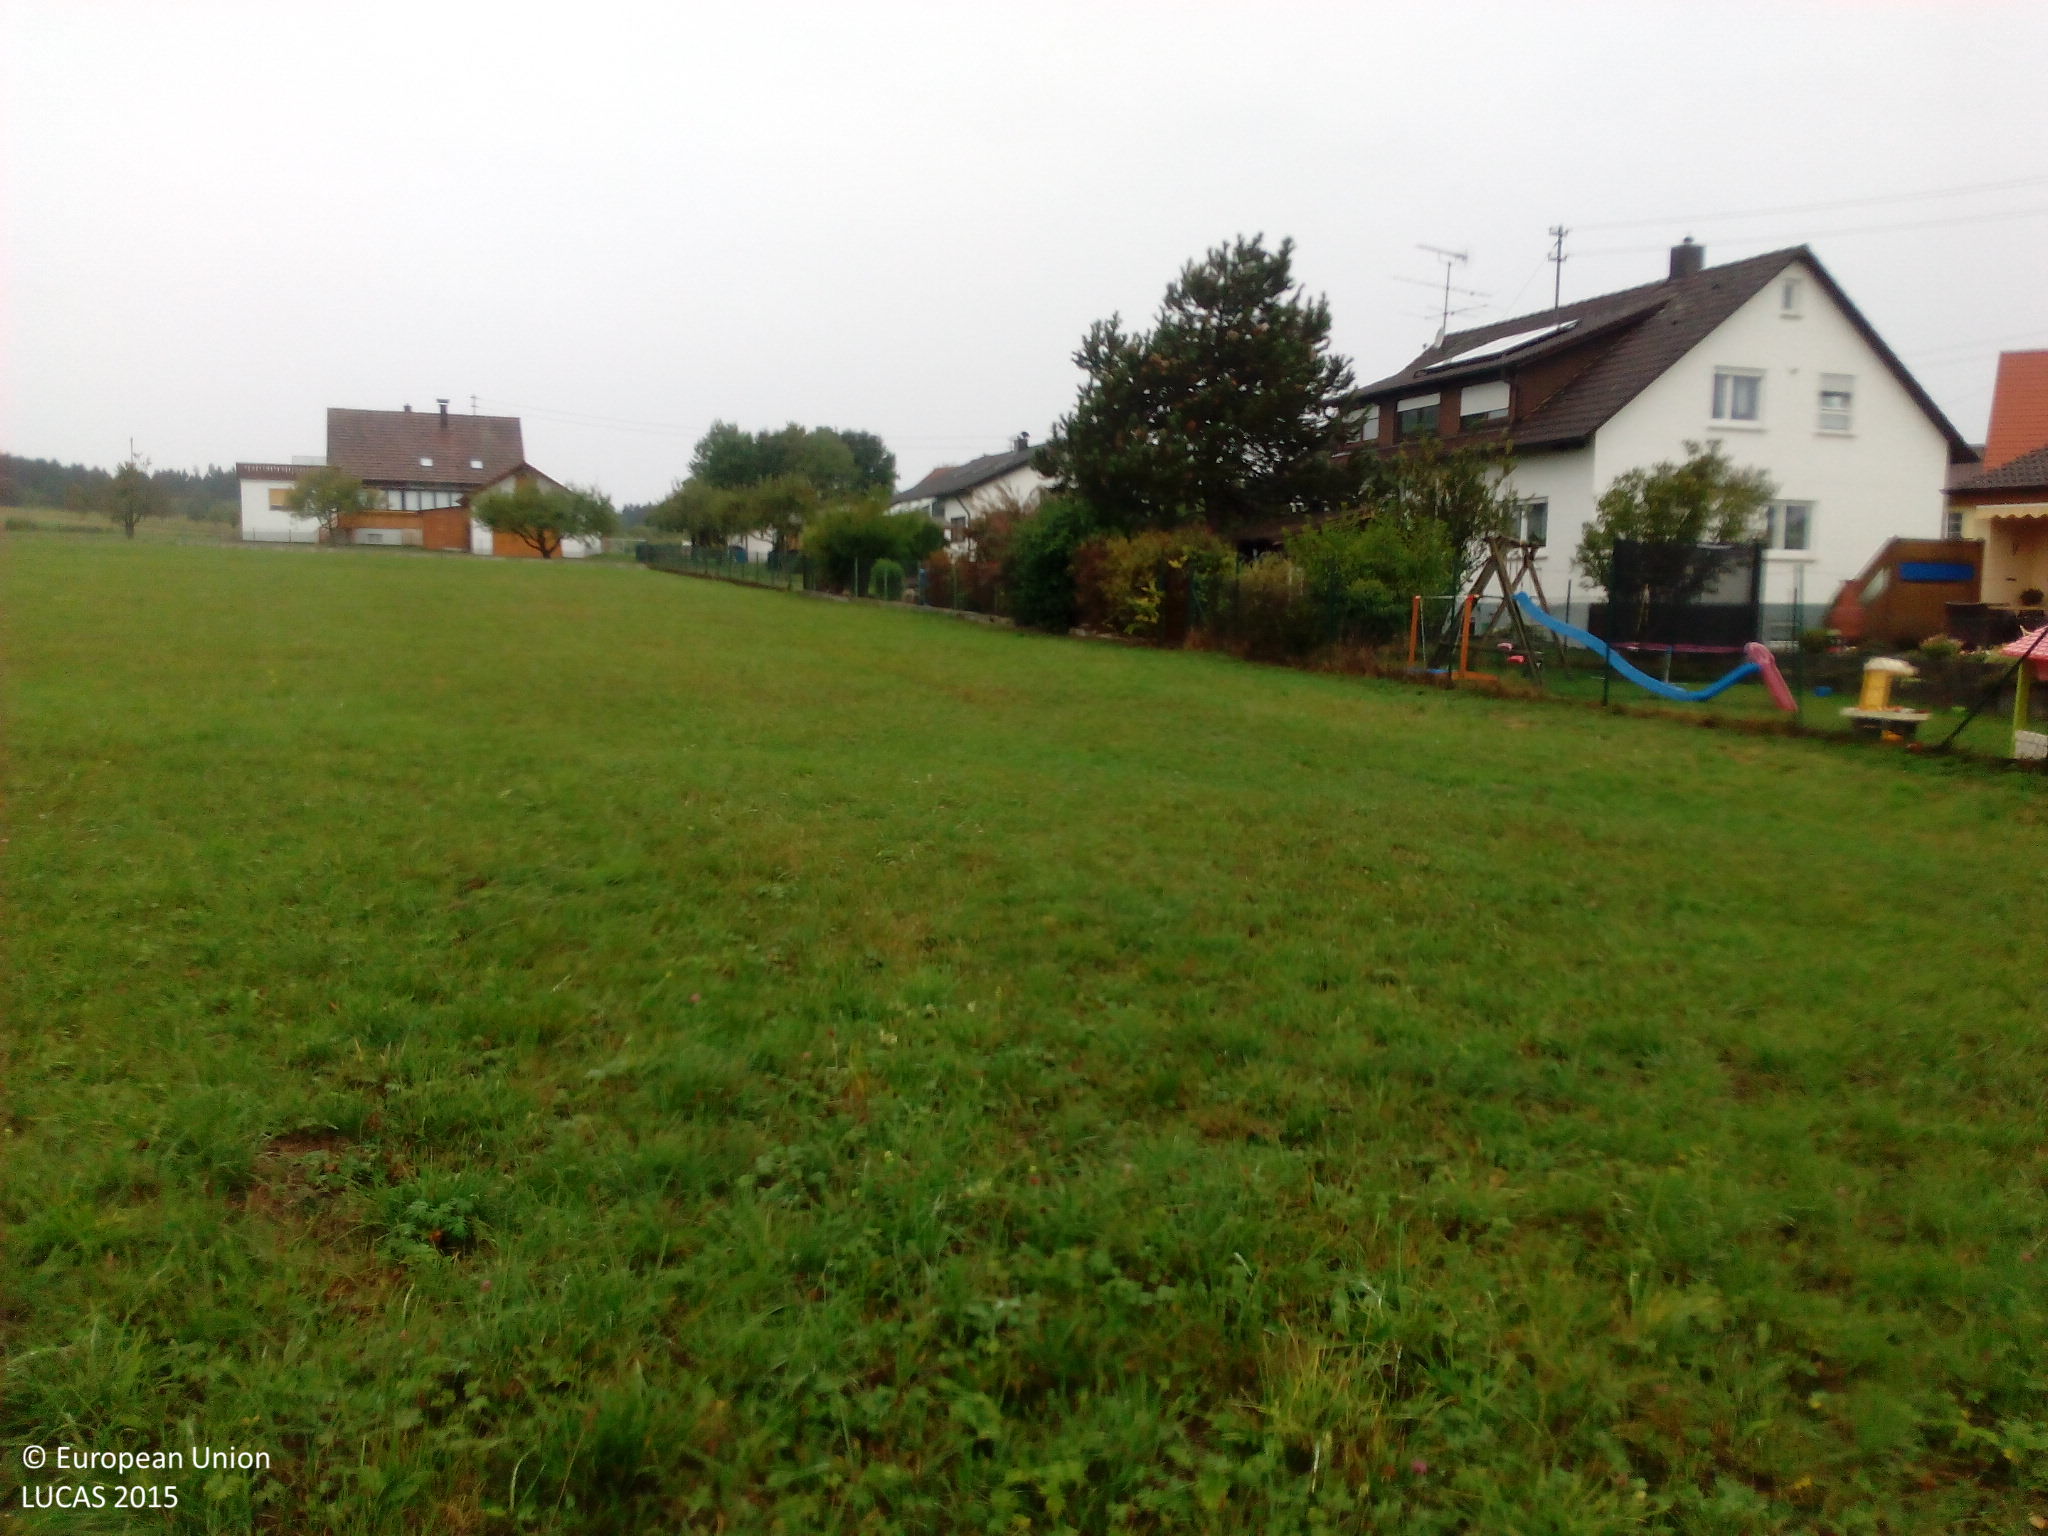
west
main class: Grassland
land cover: Grassland without tree/shrub cover
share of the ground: > 75 %
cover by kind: herbaceous plants 95 %, unconsolidated bare surface 5 %
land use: Agriculture (excluding fallow land and kitchen gardens)
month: September
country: DE
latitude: 48.1439
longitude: 8.6971
